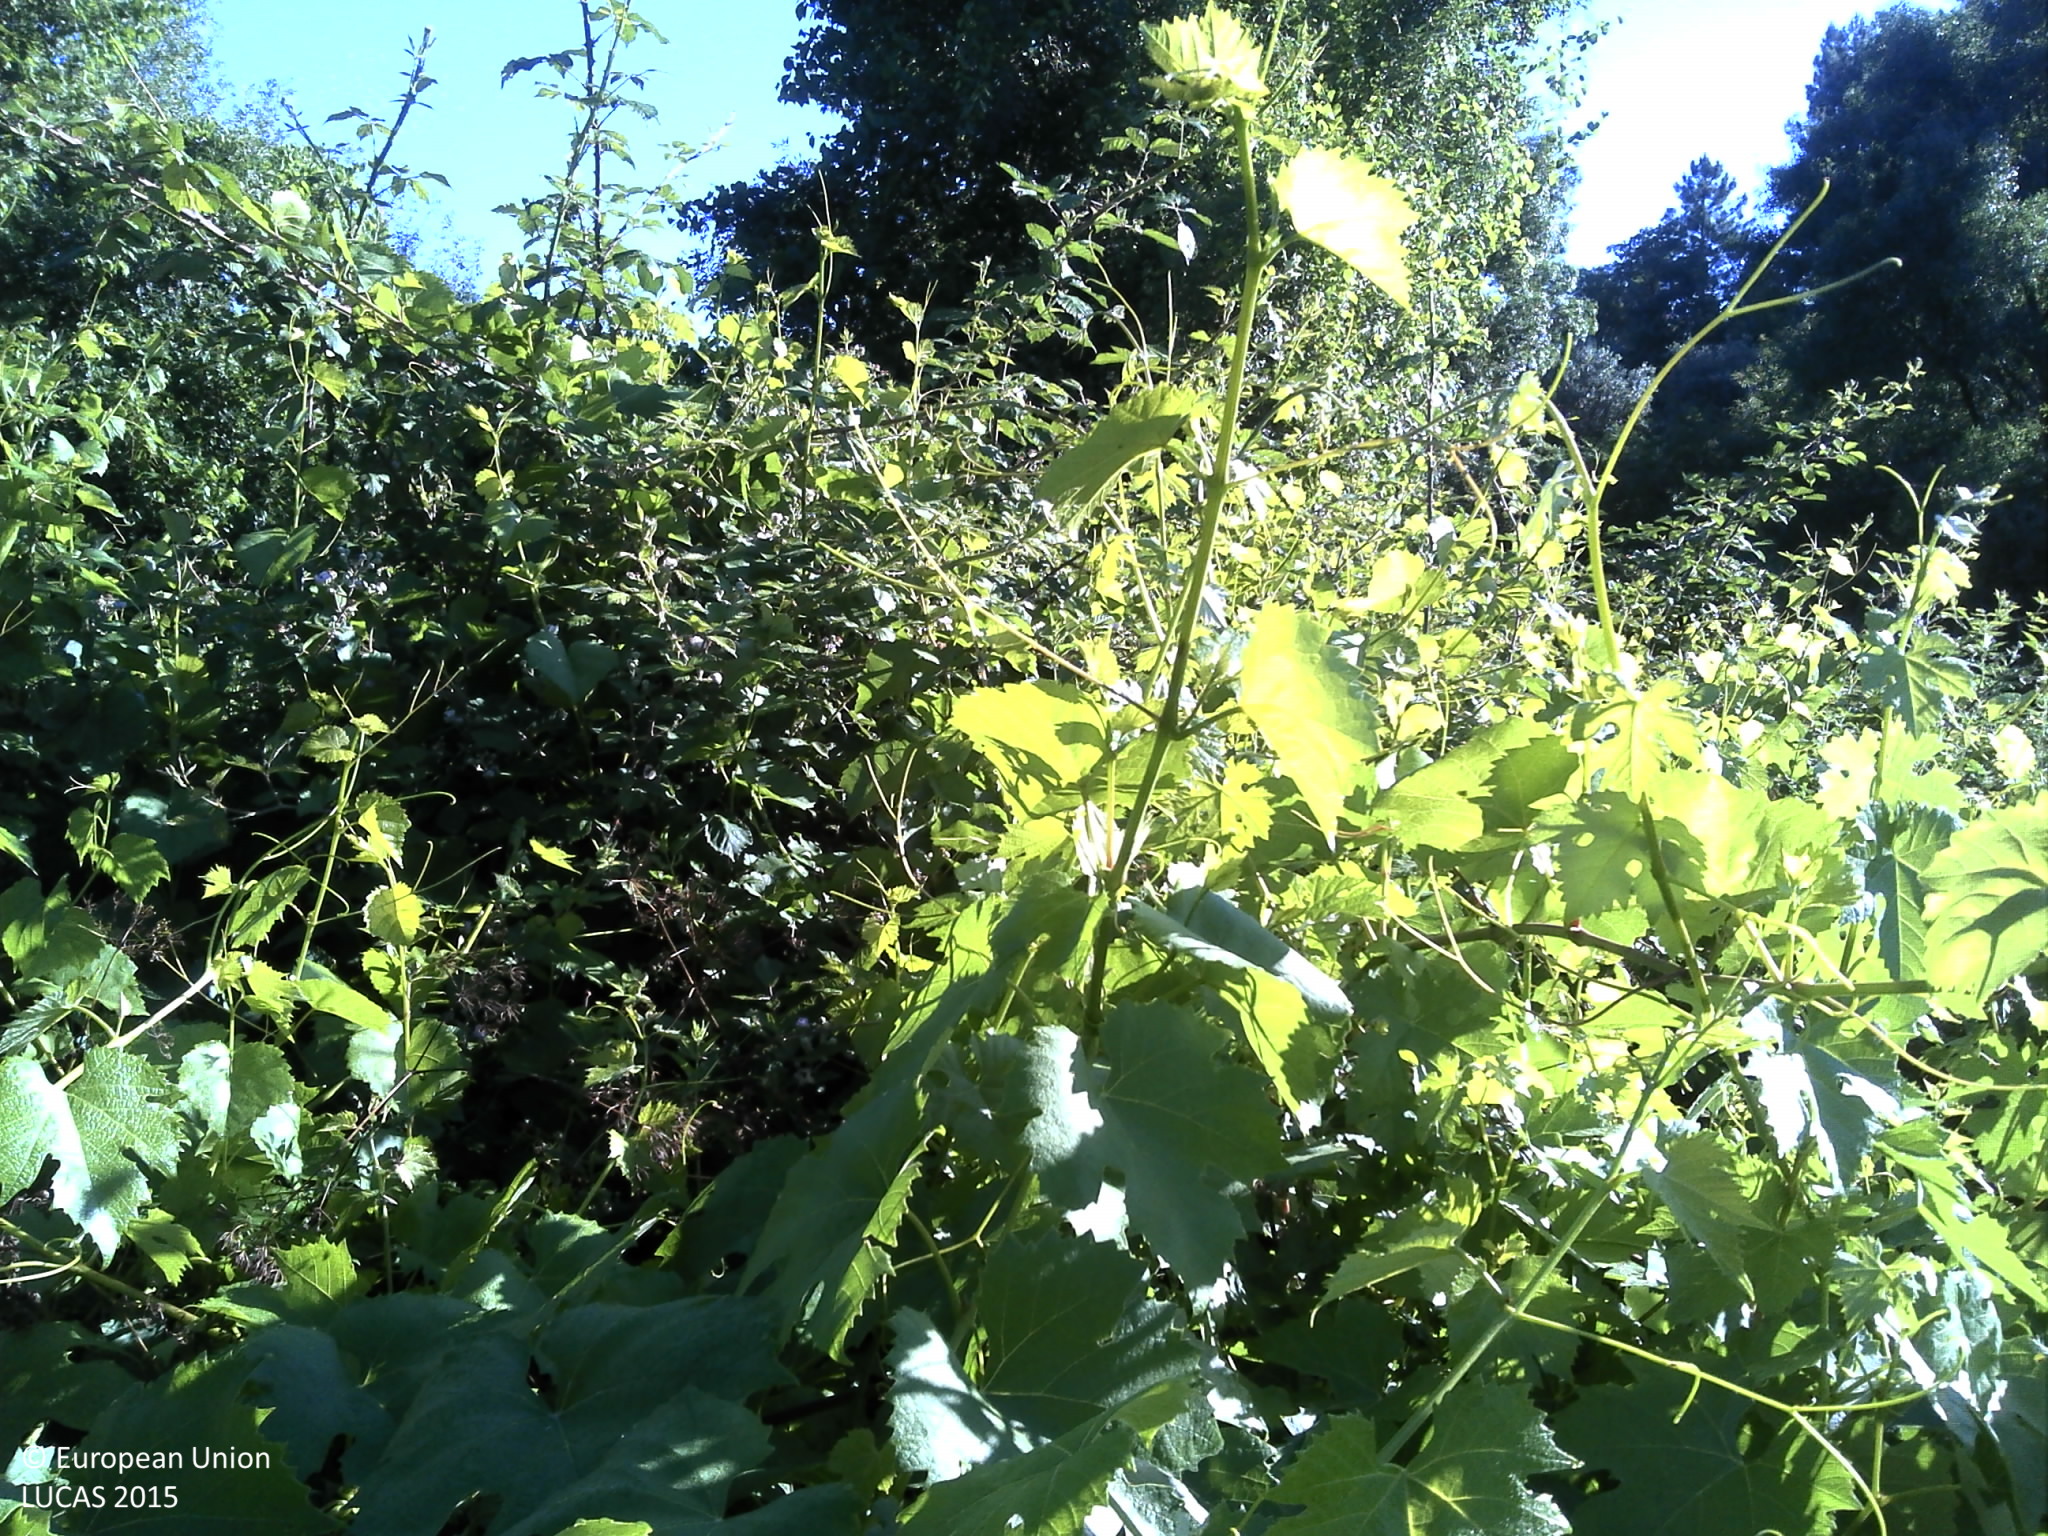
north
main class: Shrubland
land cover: Shrubland without tree cover
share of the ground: > 75 %
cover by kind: shrubs 100 %
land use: Abandoned areas
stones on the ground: < 10 %
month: June
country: PT
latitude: 40.8030
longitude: -7.1888
